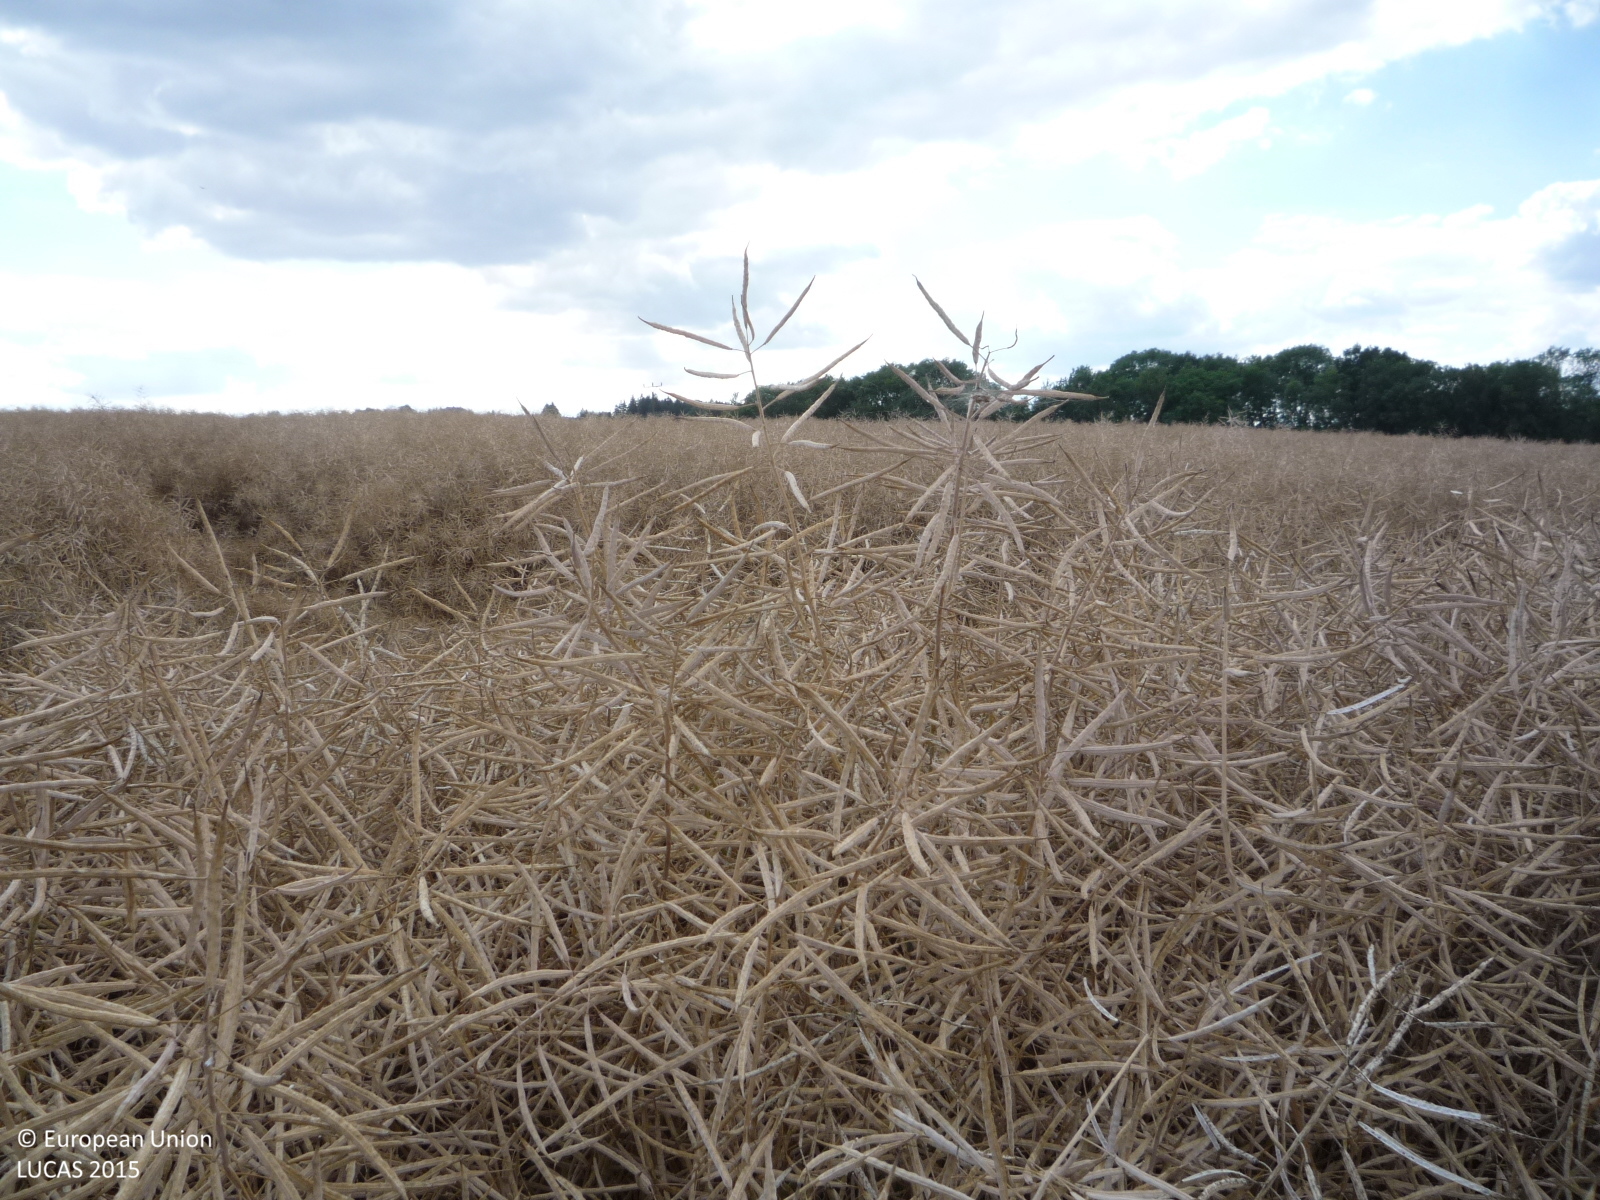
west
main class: Cropland
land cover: Rape and turnip rape
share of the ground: > 75 %
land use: Agriculture (excluding fallow land and kitchen gardens)
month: July
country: CZ
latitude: 50.4607
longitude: 15.2295
